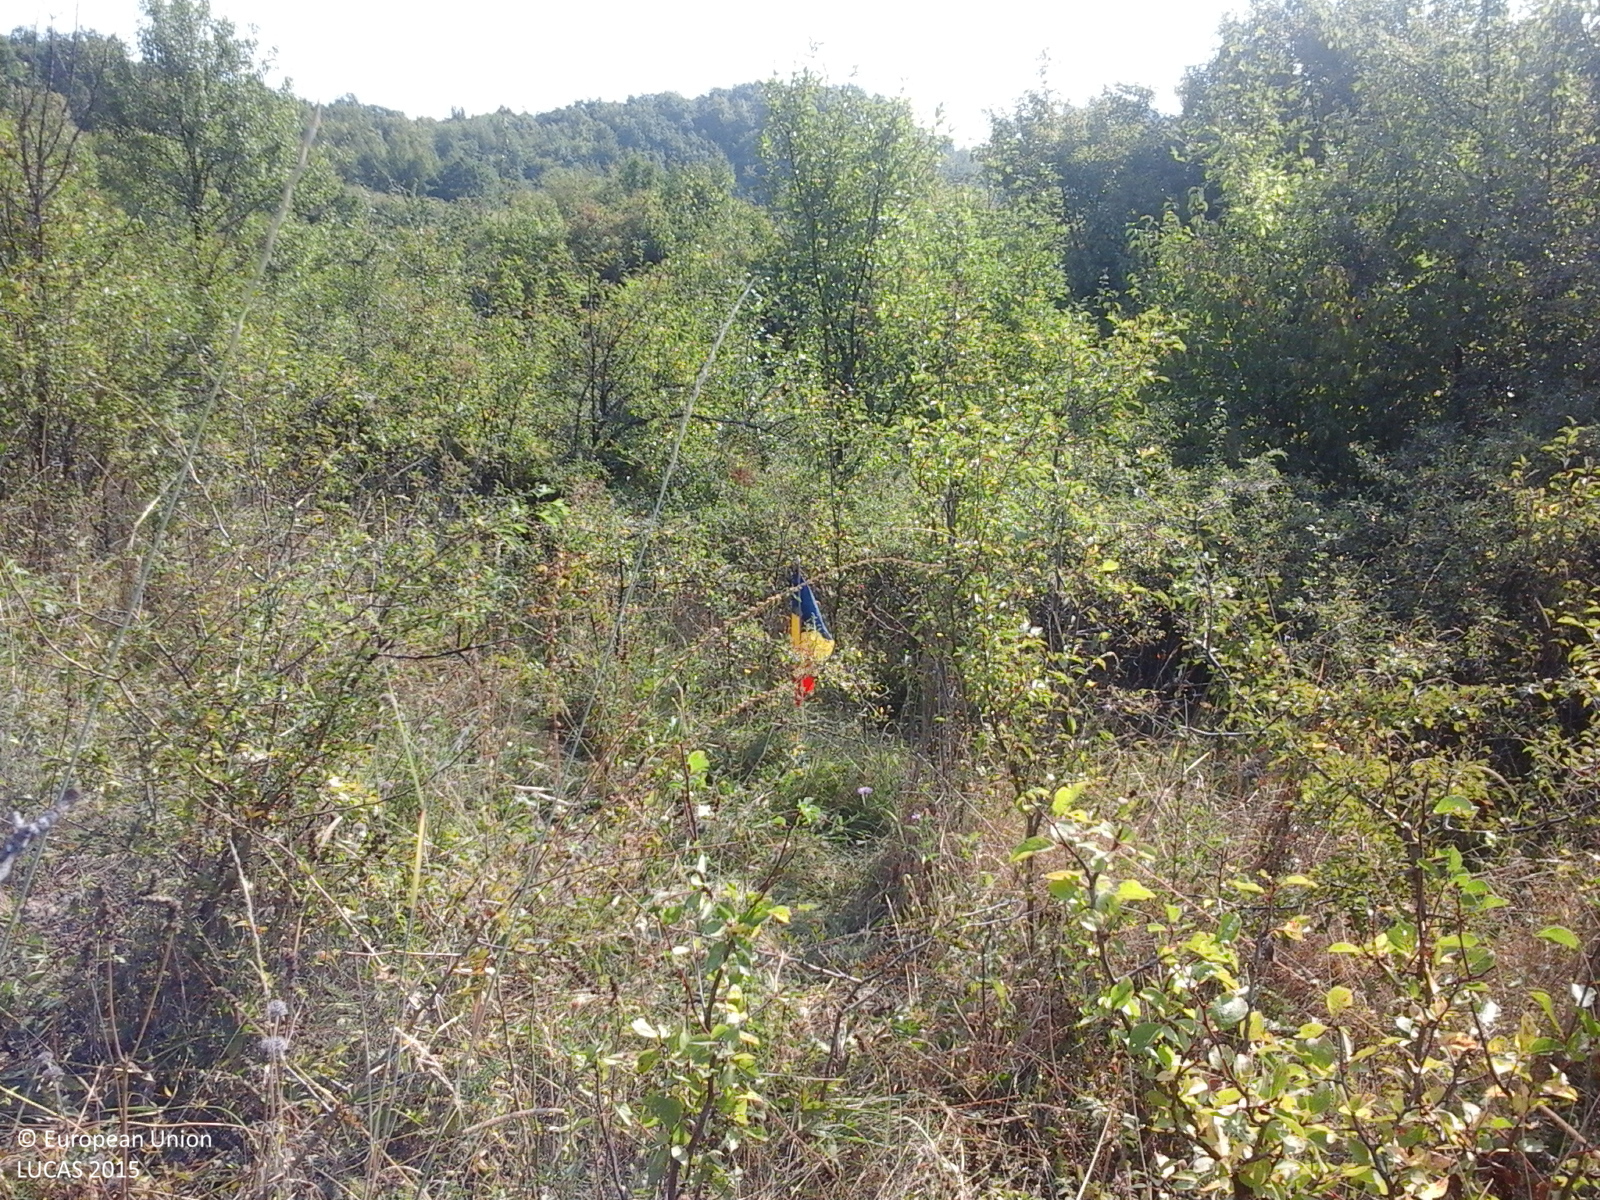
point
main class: Shrubland
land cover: Shrubland with sparse tree cover
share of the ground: > 75 %
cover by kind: shrubs 95 %, broadleaved forest trees 5 %
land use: Semi-natural and natural areas not in use
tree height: < 5 m
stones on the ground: < 10 %
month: September
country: RO
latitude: 47.0036
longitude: 24.4915
